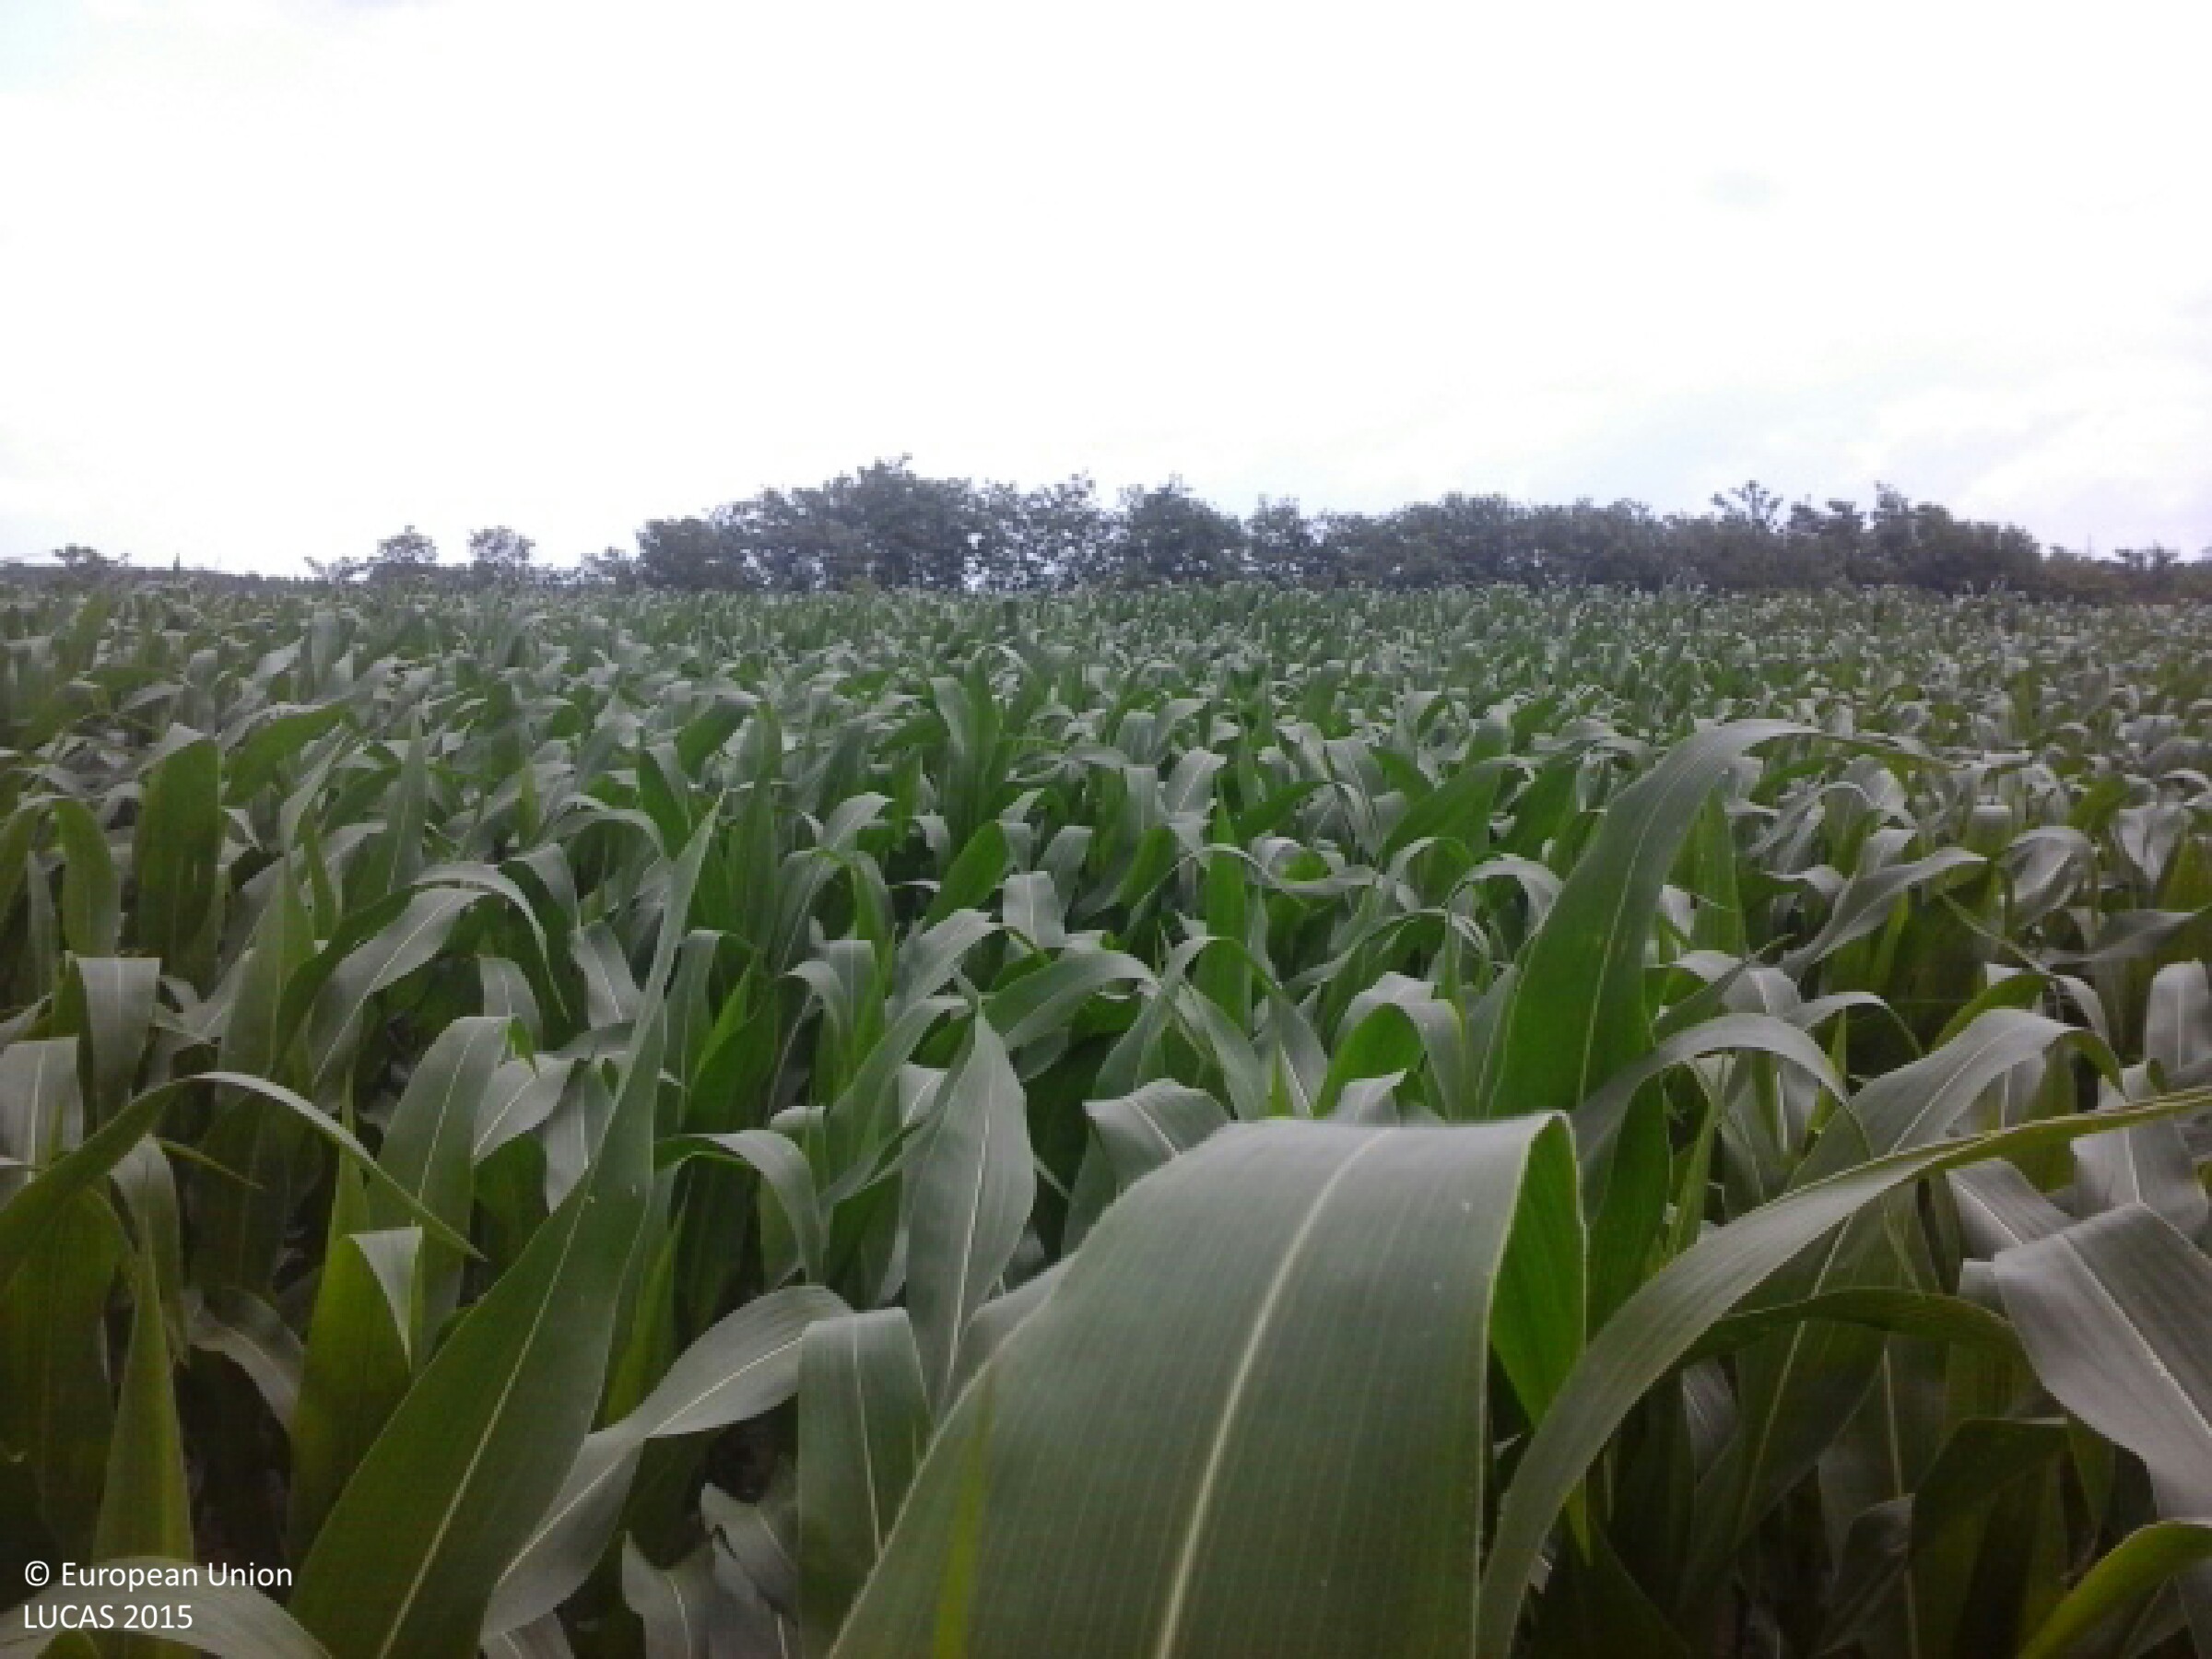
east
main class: Cropland
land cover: Maize
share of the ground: > 75 %
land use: Agriculture (excluding fallow land and kitchen gardens)
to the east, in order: Maize; Broadleaved woodland; Ditches and canals; Broadleaved woodland; Other bare soil; Sunflower
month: June
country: HU
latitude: 48.1324
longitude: 21.9707
